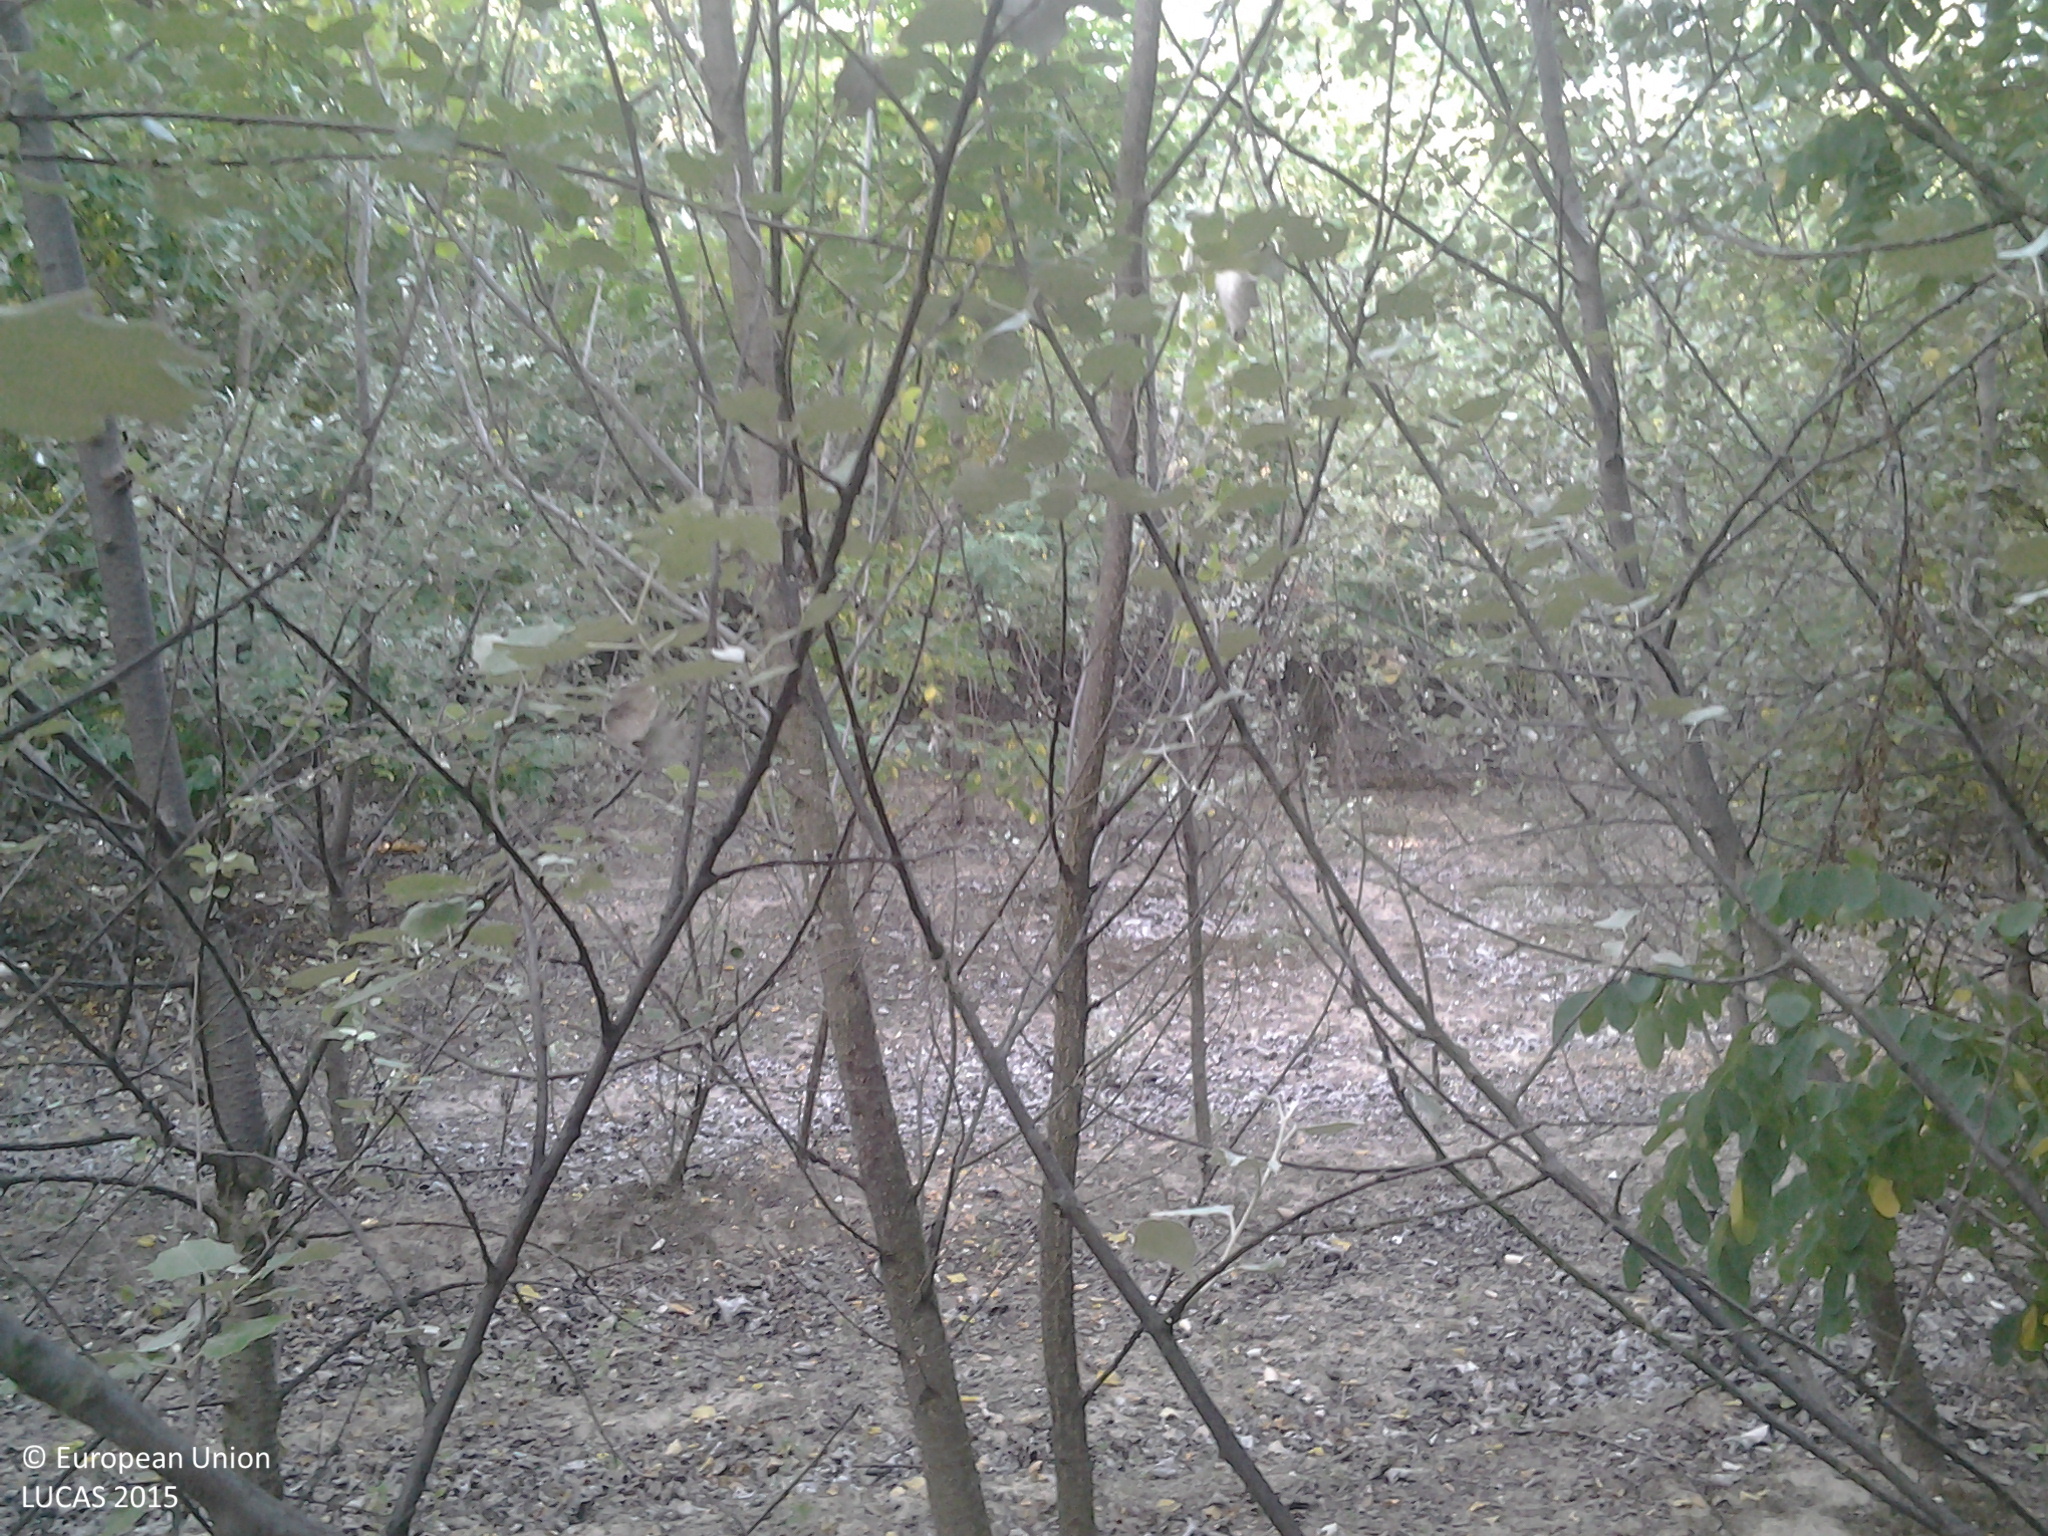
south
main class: Woodland
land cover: Broadleaved woodland
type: mesophytic deciduous forest
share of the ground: 50 - 75 %
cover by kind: broadleaved forest trees 100 %
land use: Forestry
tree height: > 5 m
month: July
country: HU
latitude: 46.9639
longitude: 19.2564
